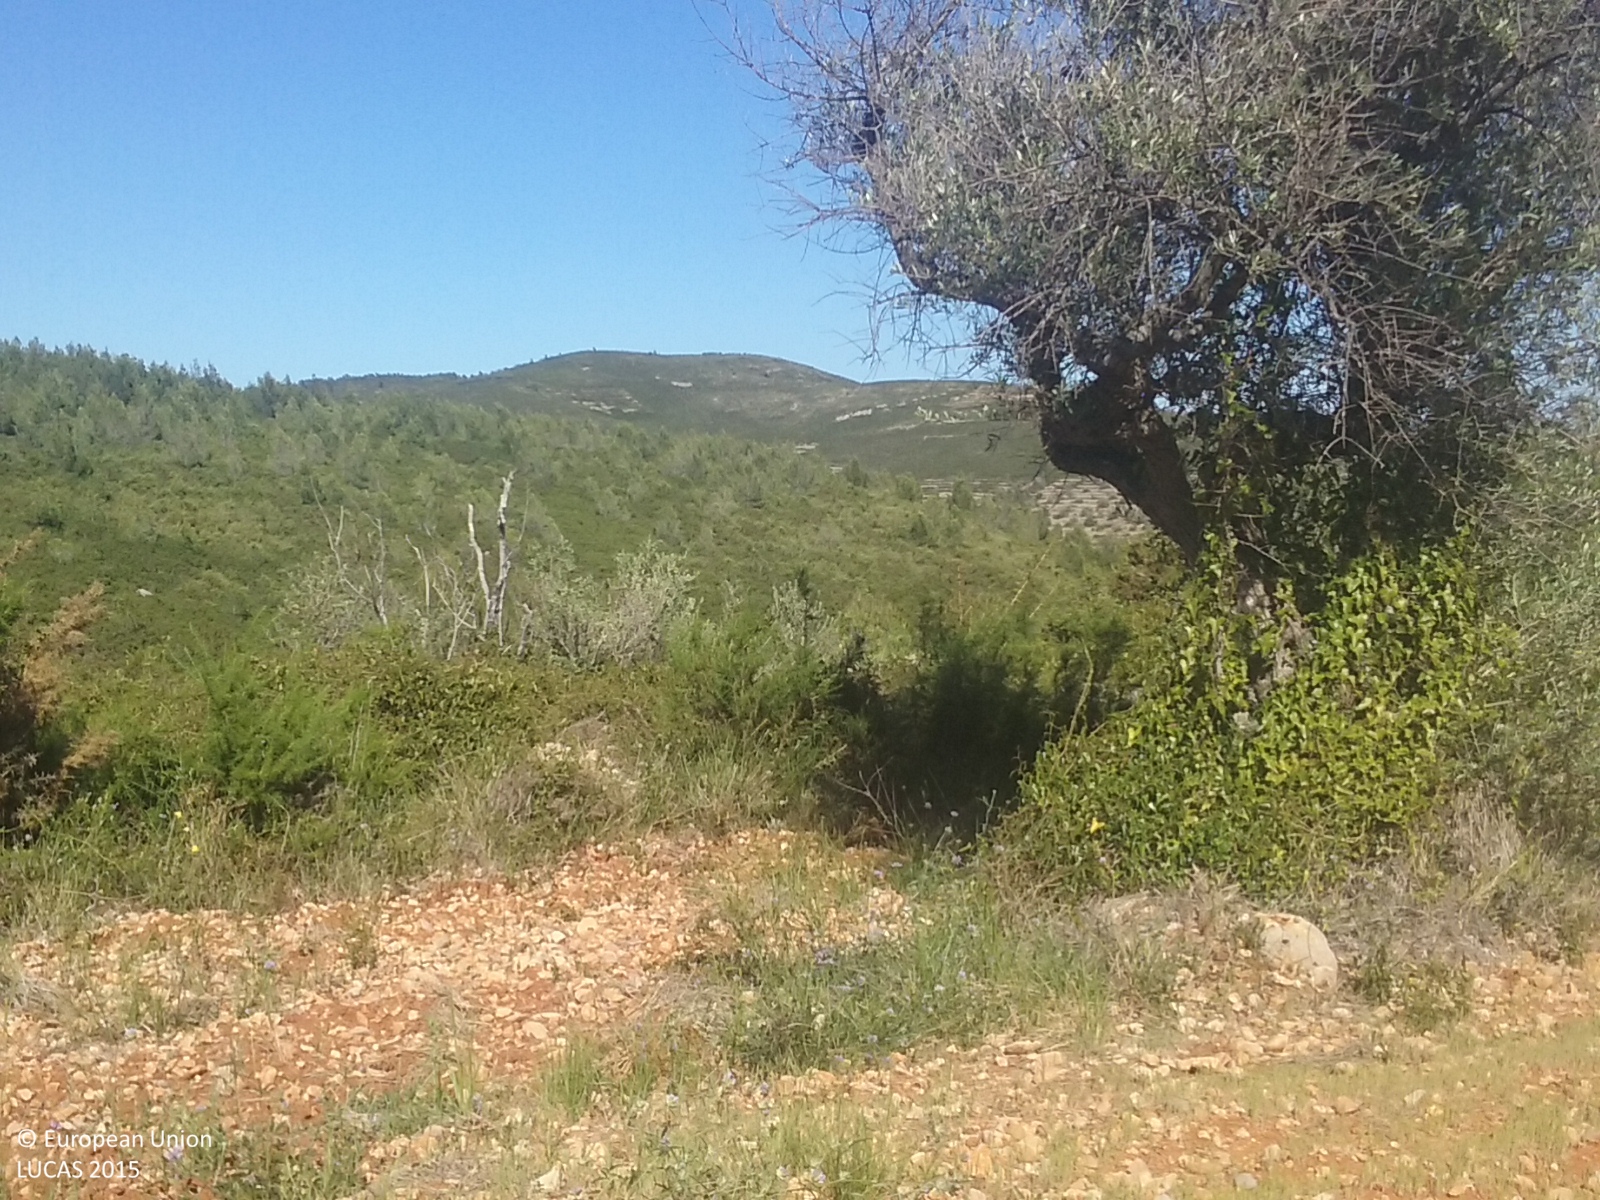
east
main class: Cropland
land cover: Olive groves
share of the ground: 25 - 50 %
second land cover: Spontaneously vegetated surfaces
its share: 10 - 25 %
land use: Agriculture (excluding fallow land and kitchen gardens)
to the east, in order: Olive groves; Spontaneously vegetated surfaces; Dry stone walls; Olive groves; Dry stone walls; Shrubland with sparse tree cover
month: May
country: ES
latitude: 40.3797
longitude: 0.2319
